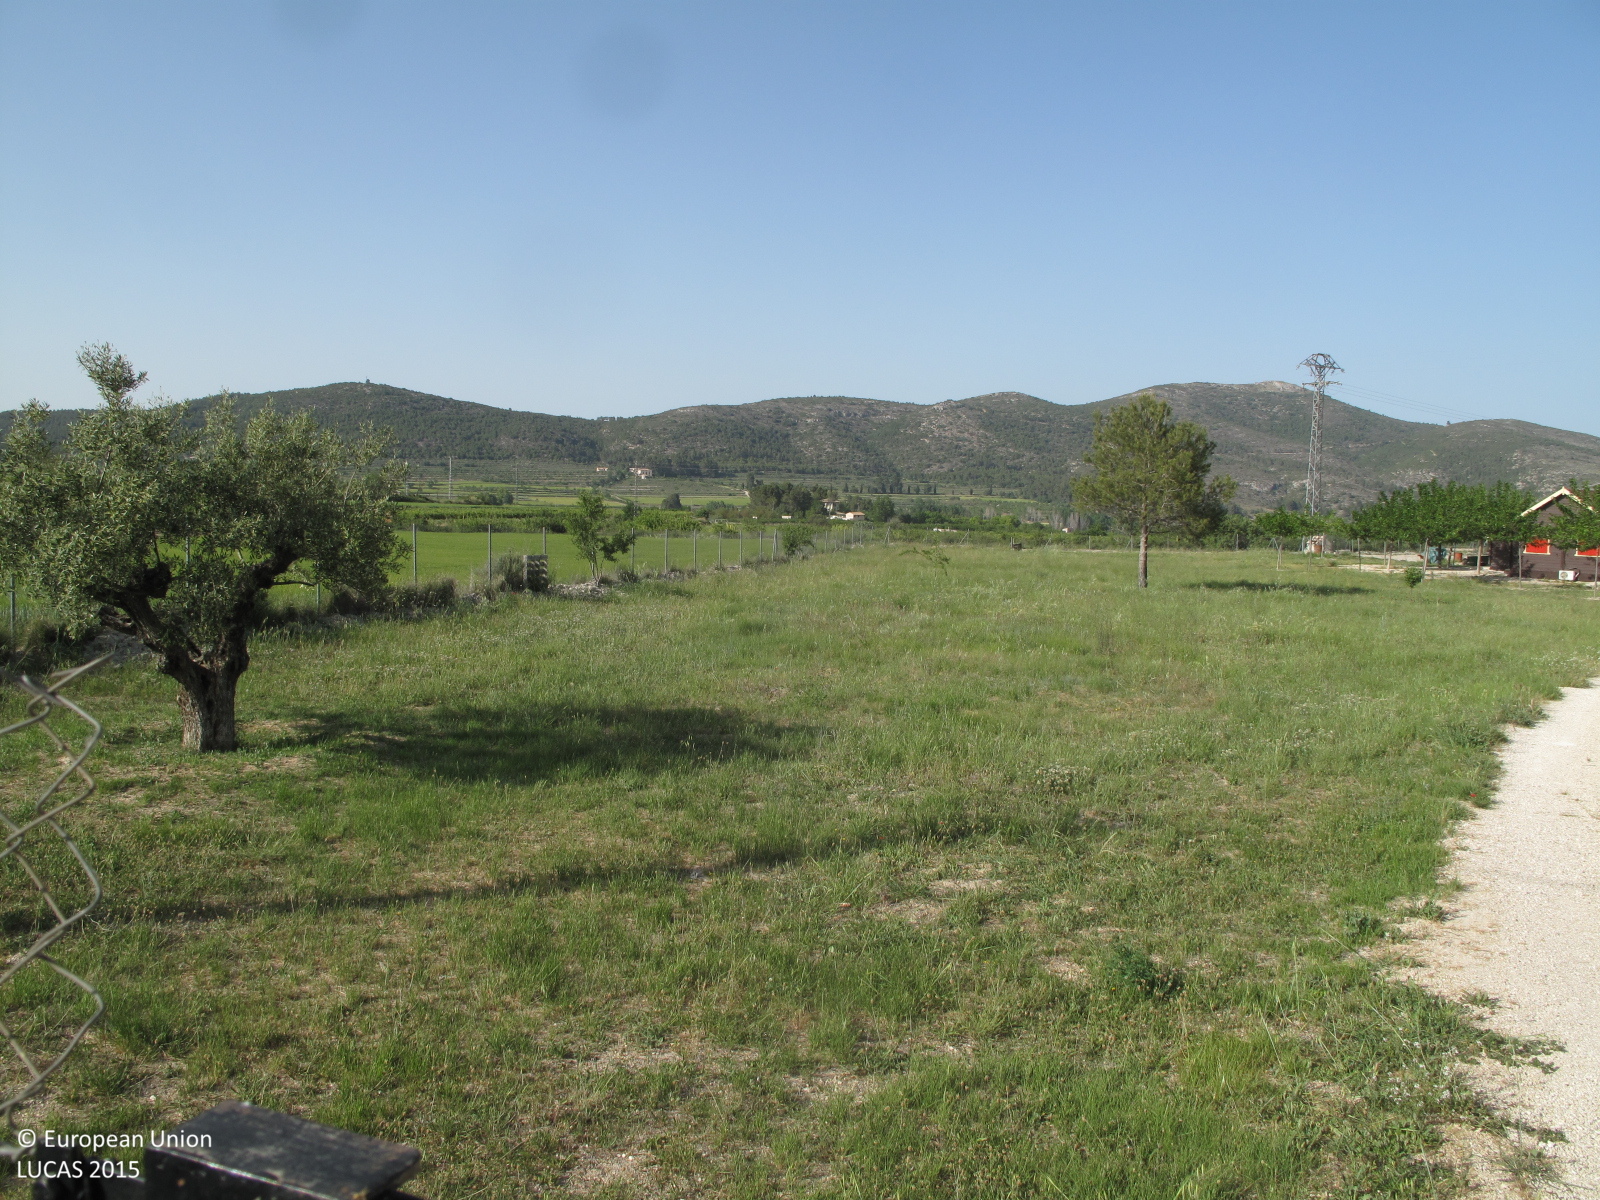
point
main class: Grassland
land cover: Grassland with sparse tree/shrub cover
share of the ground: > 75 %
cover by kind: herbaceous plants 95 %, broadleaved forest trees 5 %
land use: Residential
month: May
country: ES
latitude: 38.7875
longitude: -0.5243
